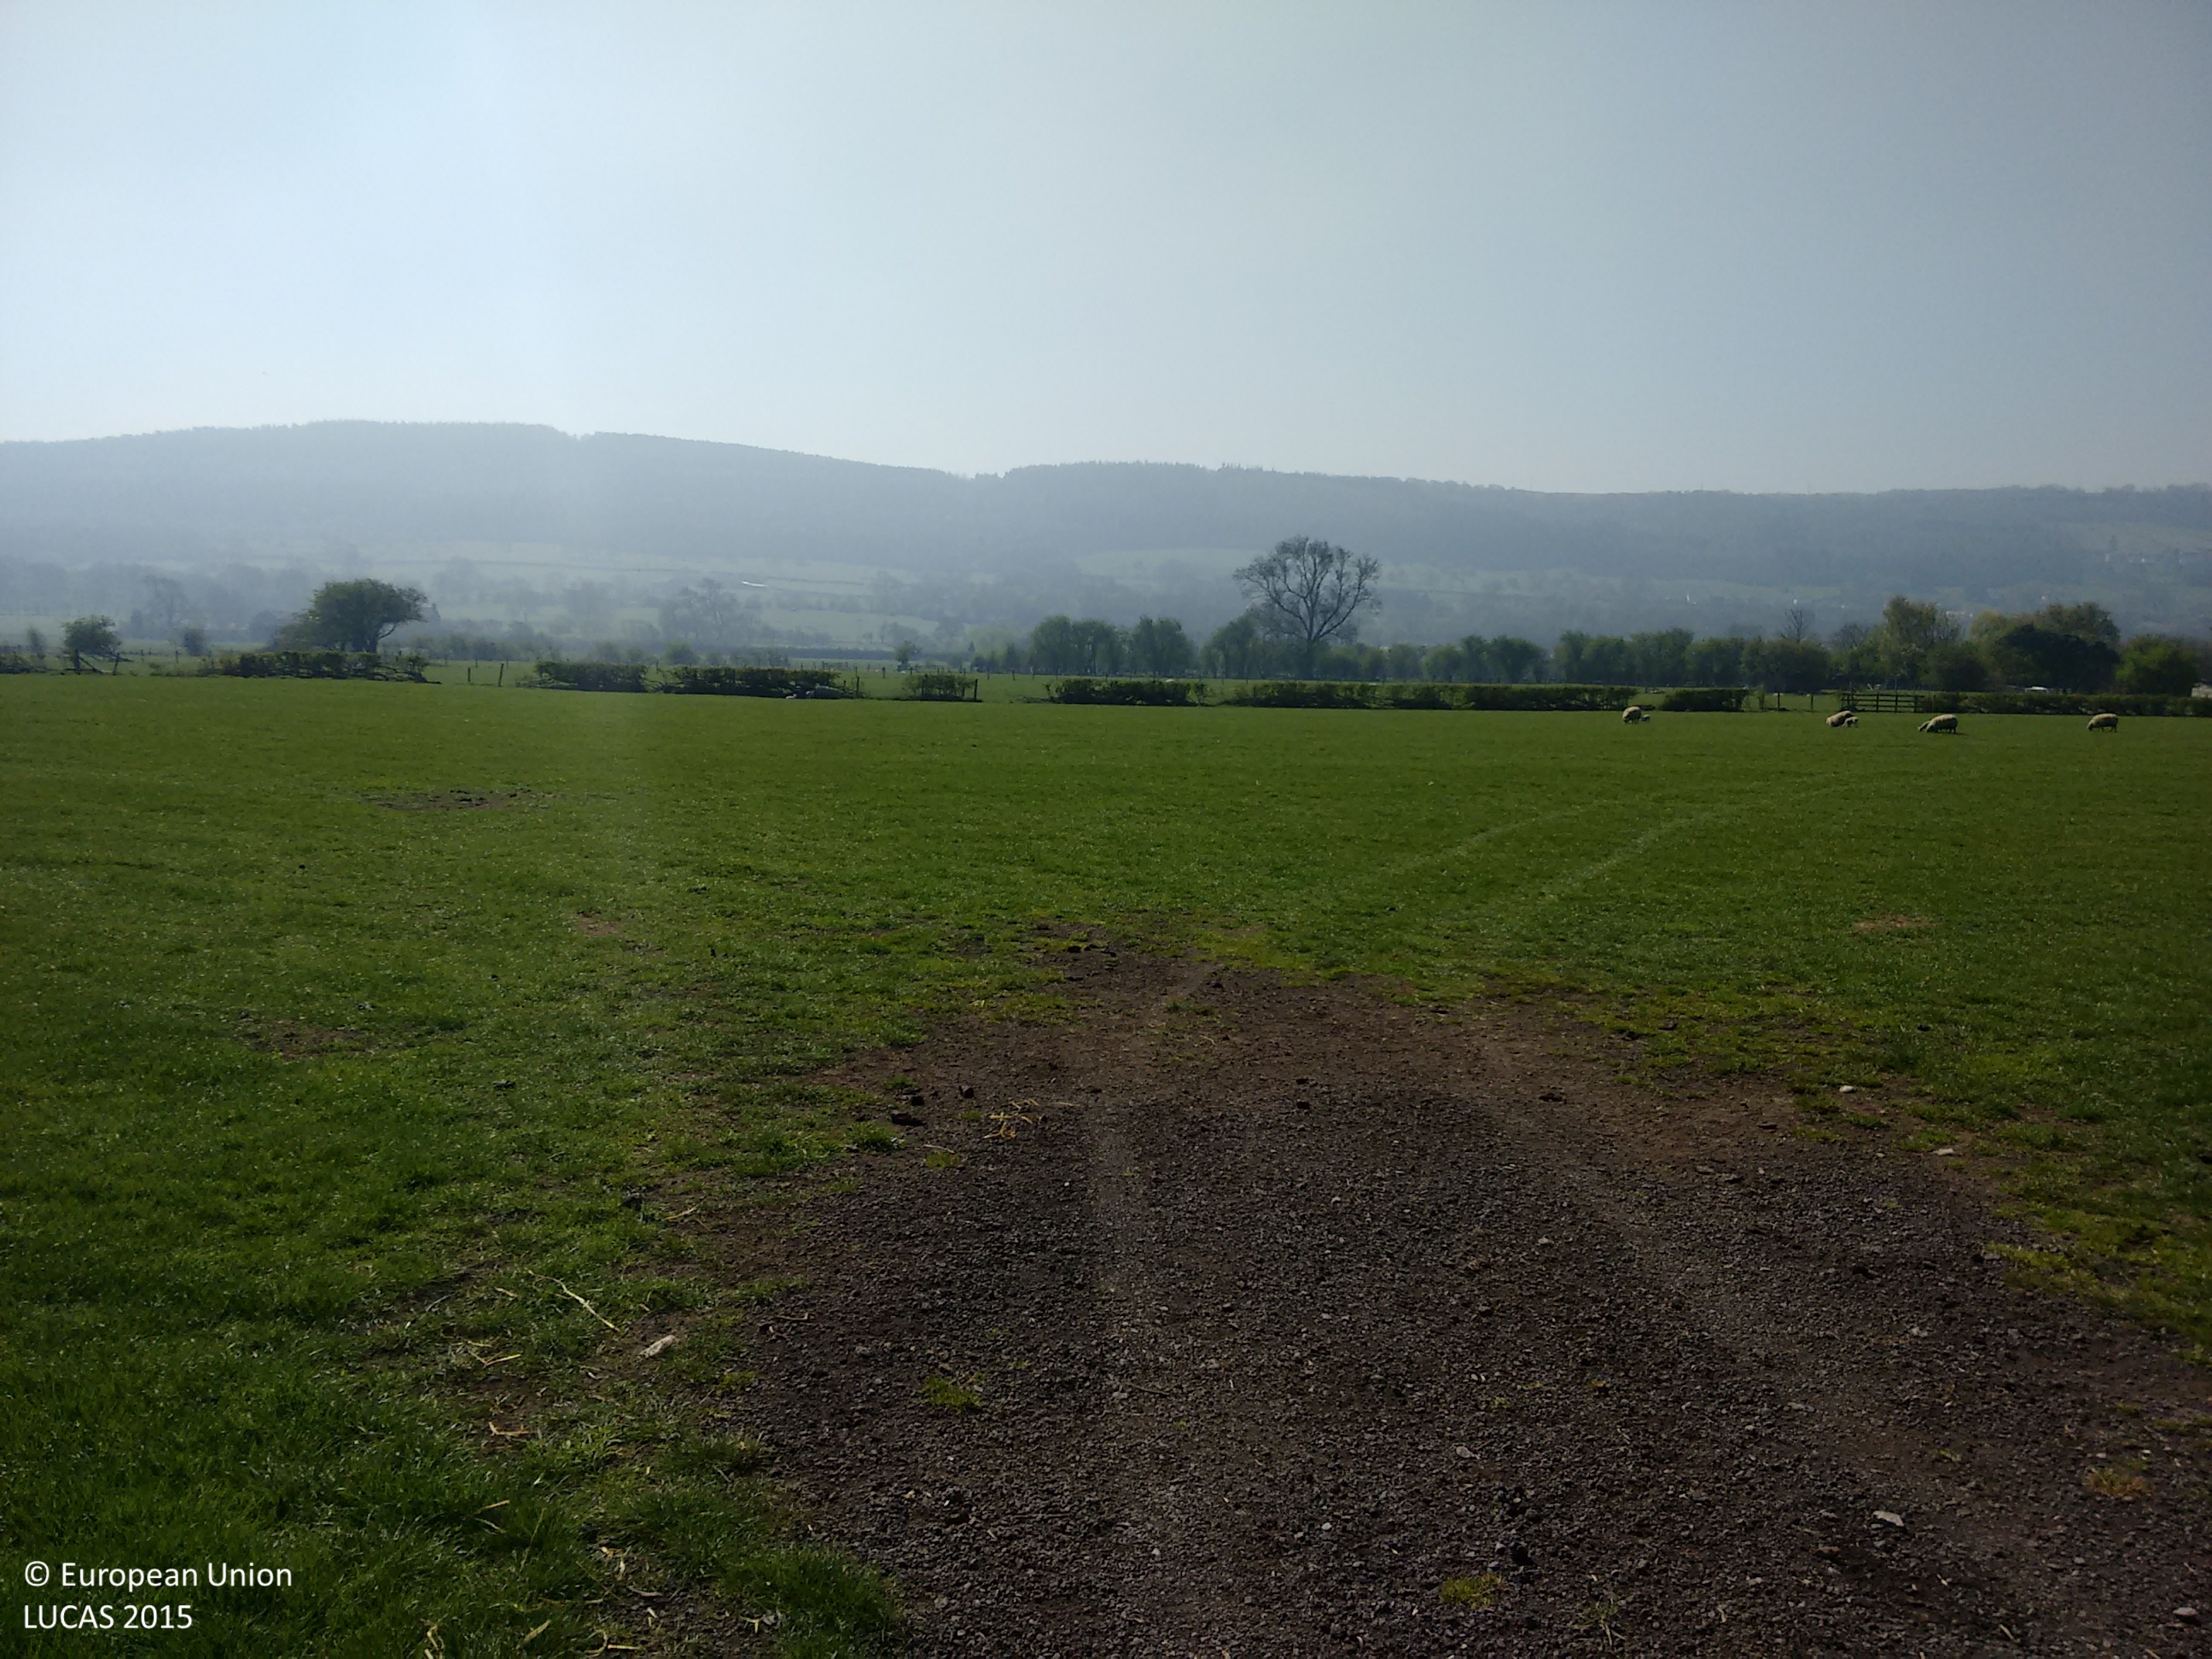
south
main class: Grassland
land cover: Grassland without tree/shrub cover
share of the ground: > 75 %
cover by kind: herbaceous plants 100 %
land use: Agriculture (excluding fallow land and kitchen gardens)
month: April
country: GB
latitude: 53.9081
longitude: -1.6664
